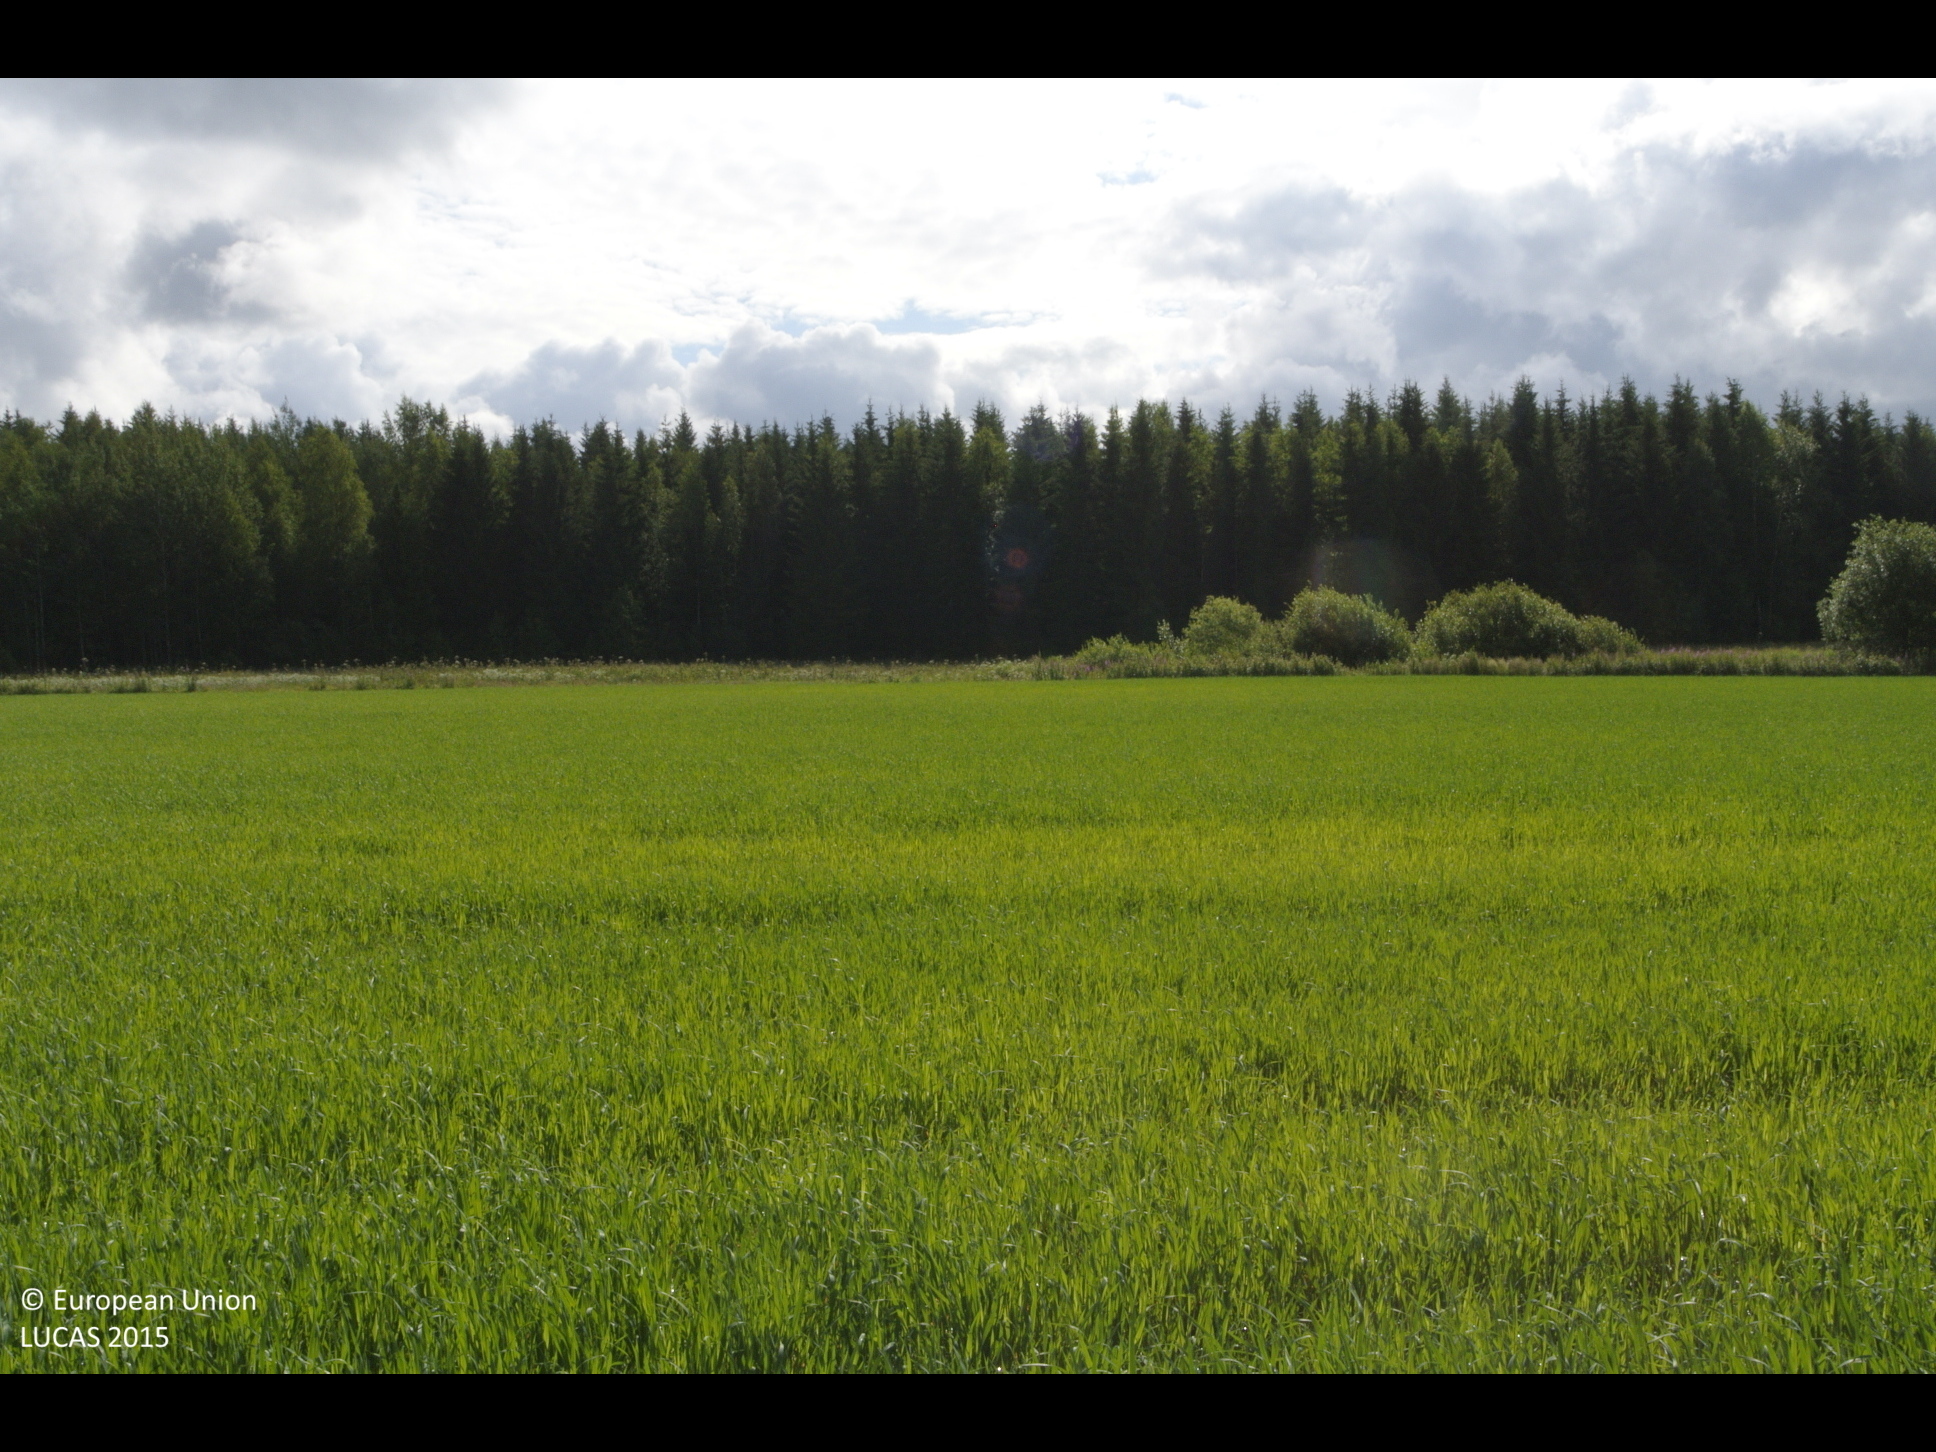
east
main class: Cropland
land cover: Oats
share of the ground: > 75 %
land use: Agriculture (excluding fallow land and kitchen gardens)
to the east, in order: Oats; Grass margins; Ditches and canals; Grass margins; Arable land (only in case pi); Grass margins; Ditches and canals; Grass margins; Arable land (only in case pi); Spruce dominated mixed woodland; Broadleaved woodland; Spruce dominated coniferous woodland
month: July
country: FI
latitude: 61.4744
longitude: 25.8030
